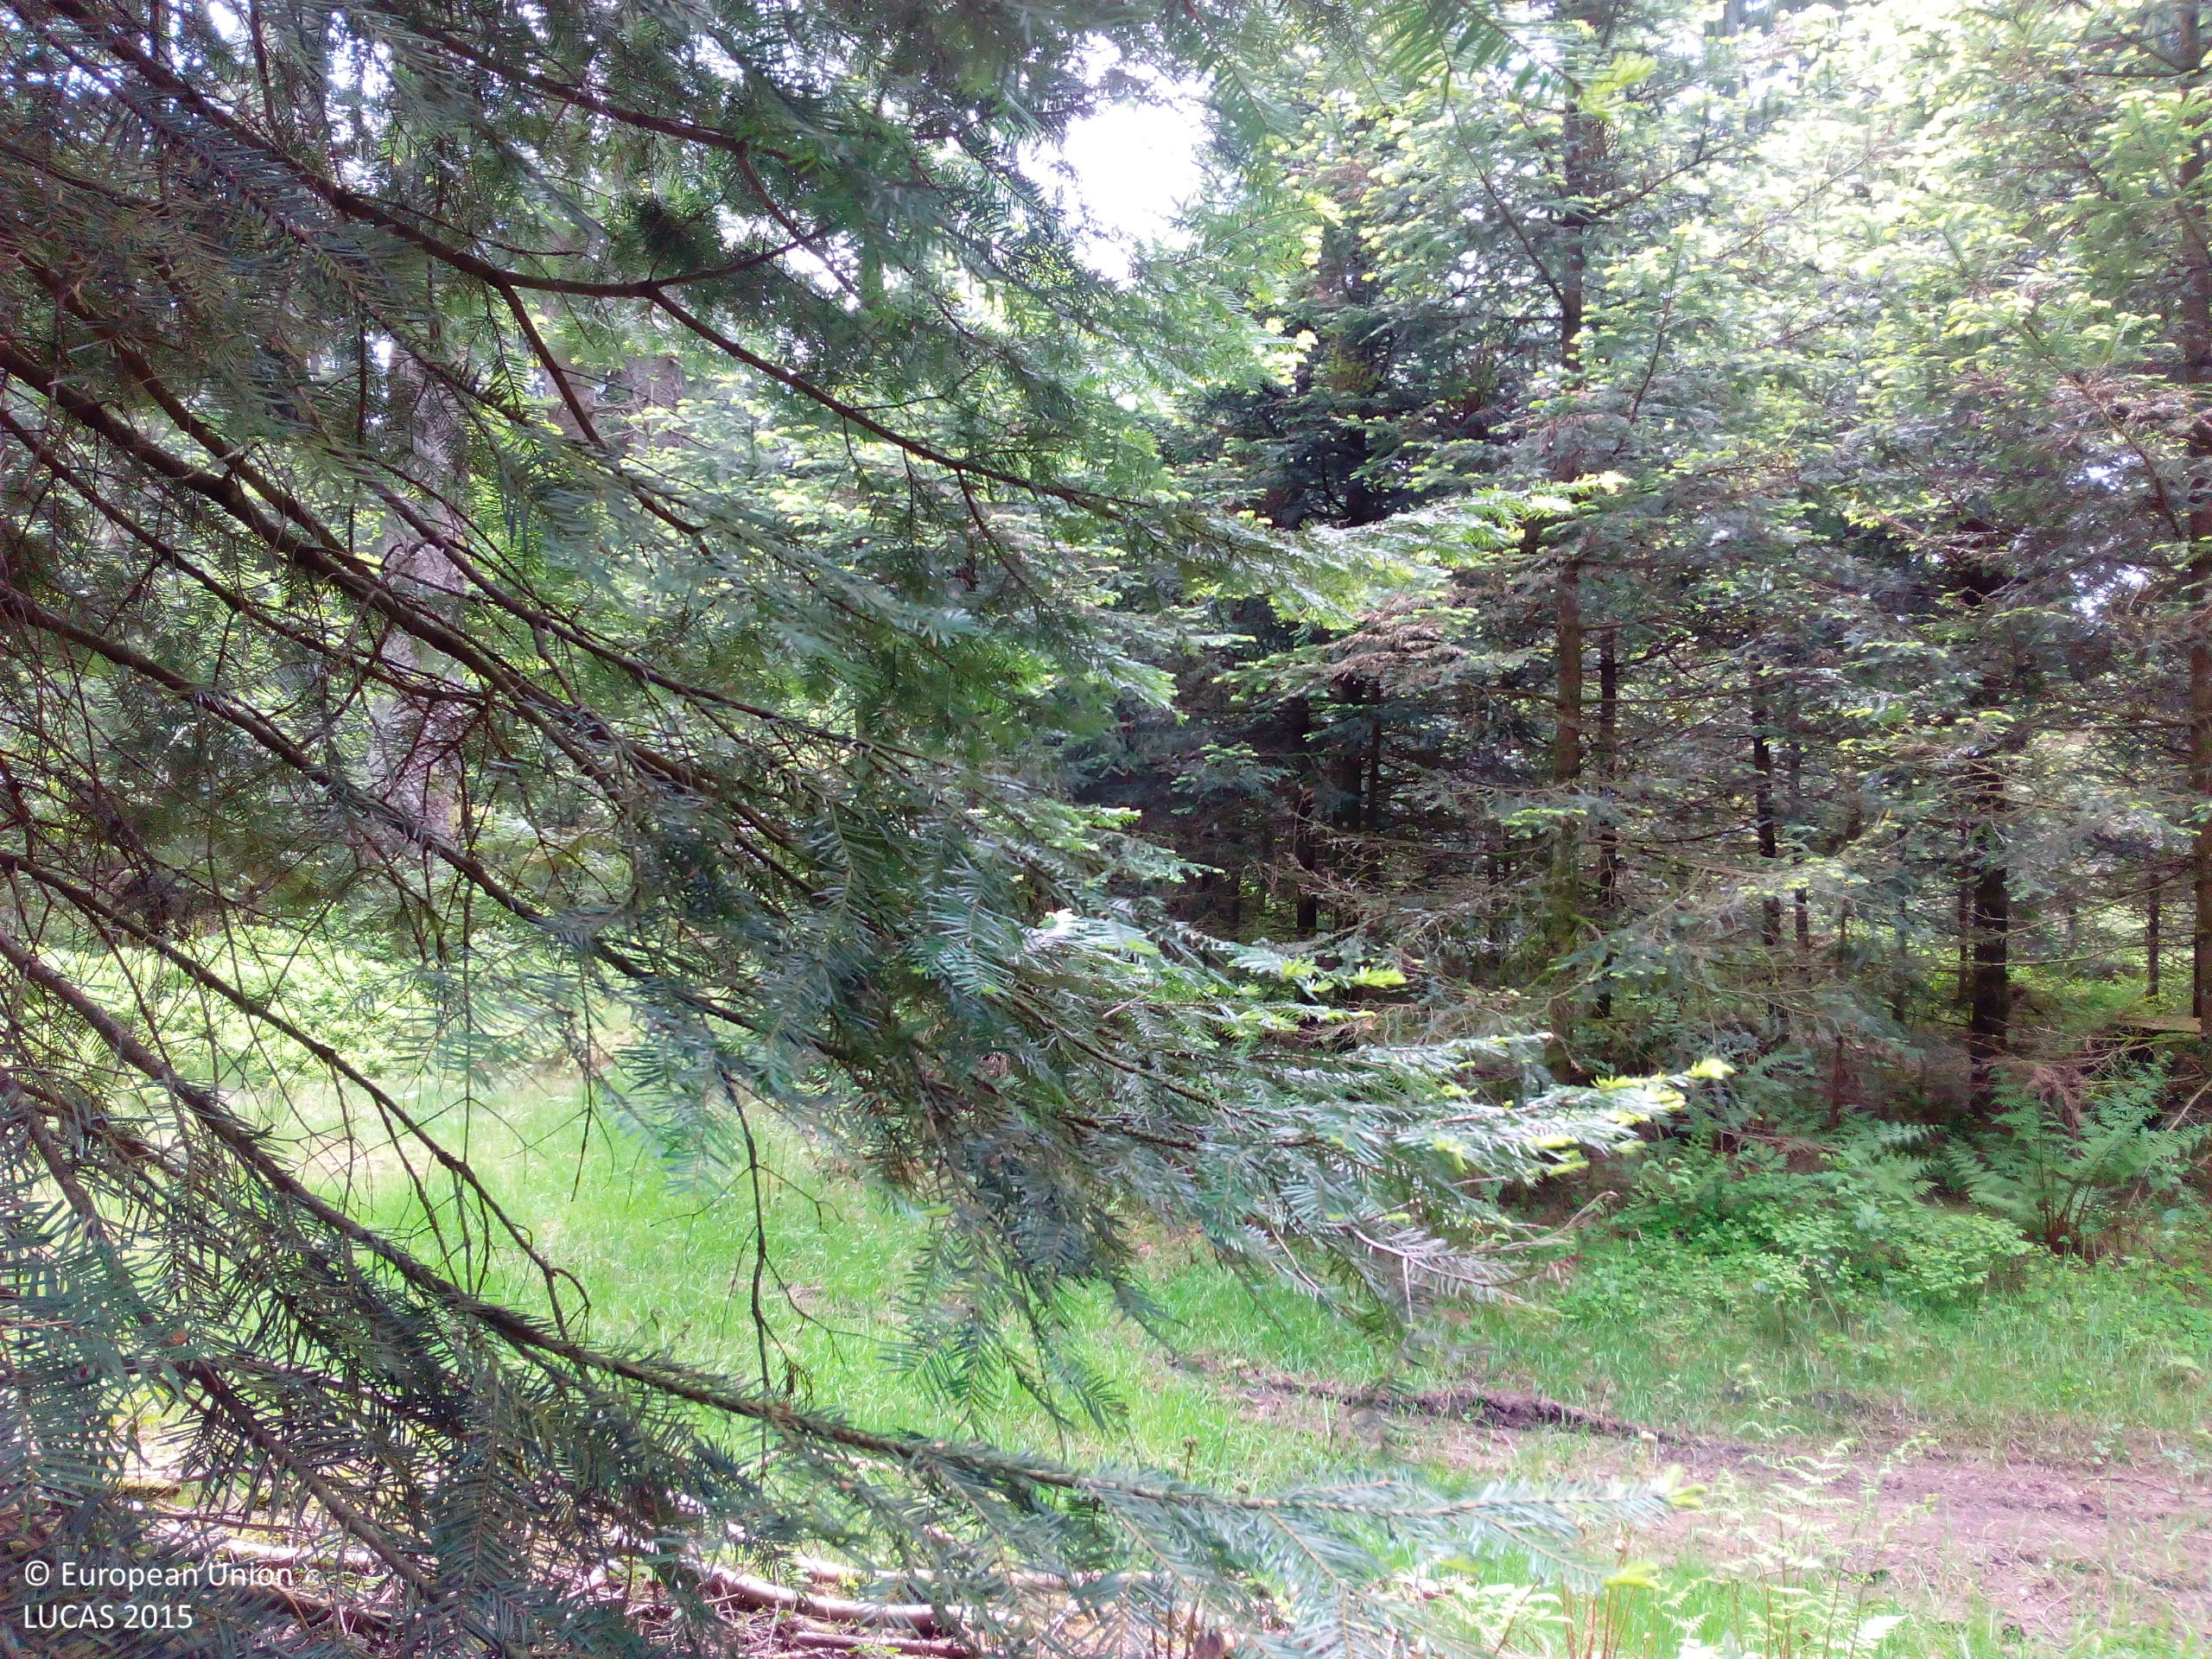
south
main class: Woodland
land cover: Other mixed woodland
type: hemiboreal forest and nemoral coniferous forest and mixed broadleaved-coniferous forest
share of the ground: > 75 %
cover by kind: coniferous forest trees 70 %, broadleaved forest trees 30 %
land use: Forestry
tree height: > 5 m
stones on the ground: < 10 %
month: May
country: DE
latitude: 47.9918
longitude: 8.1384
